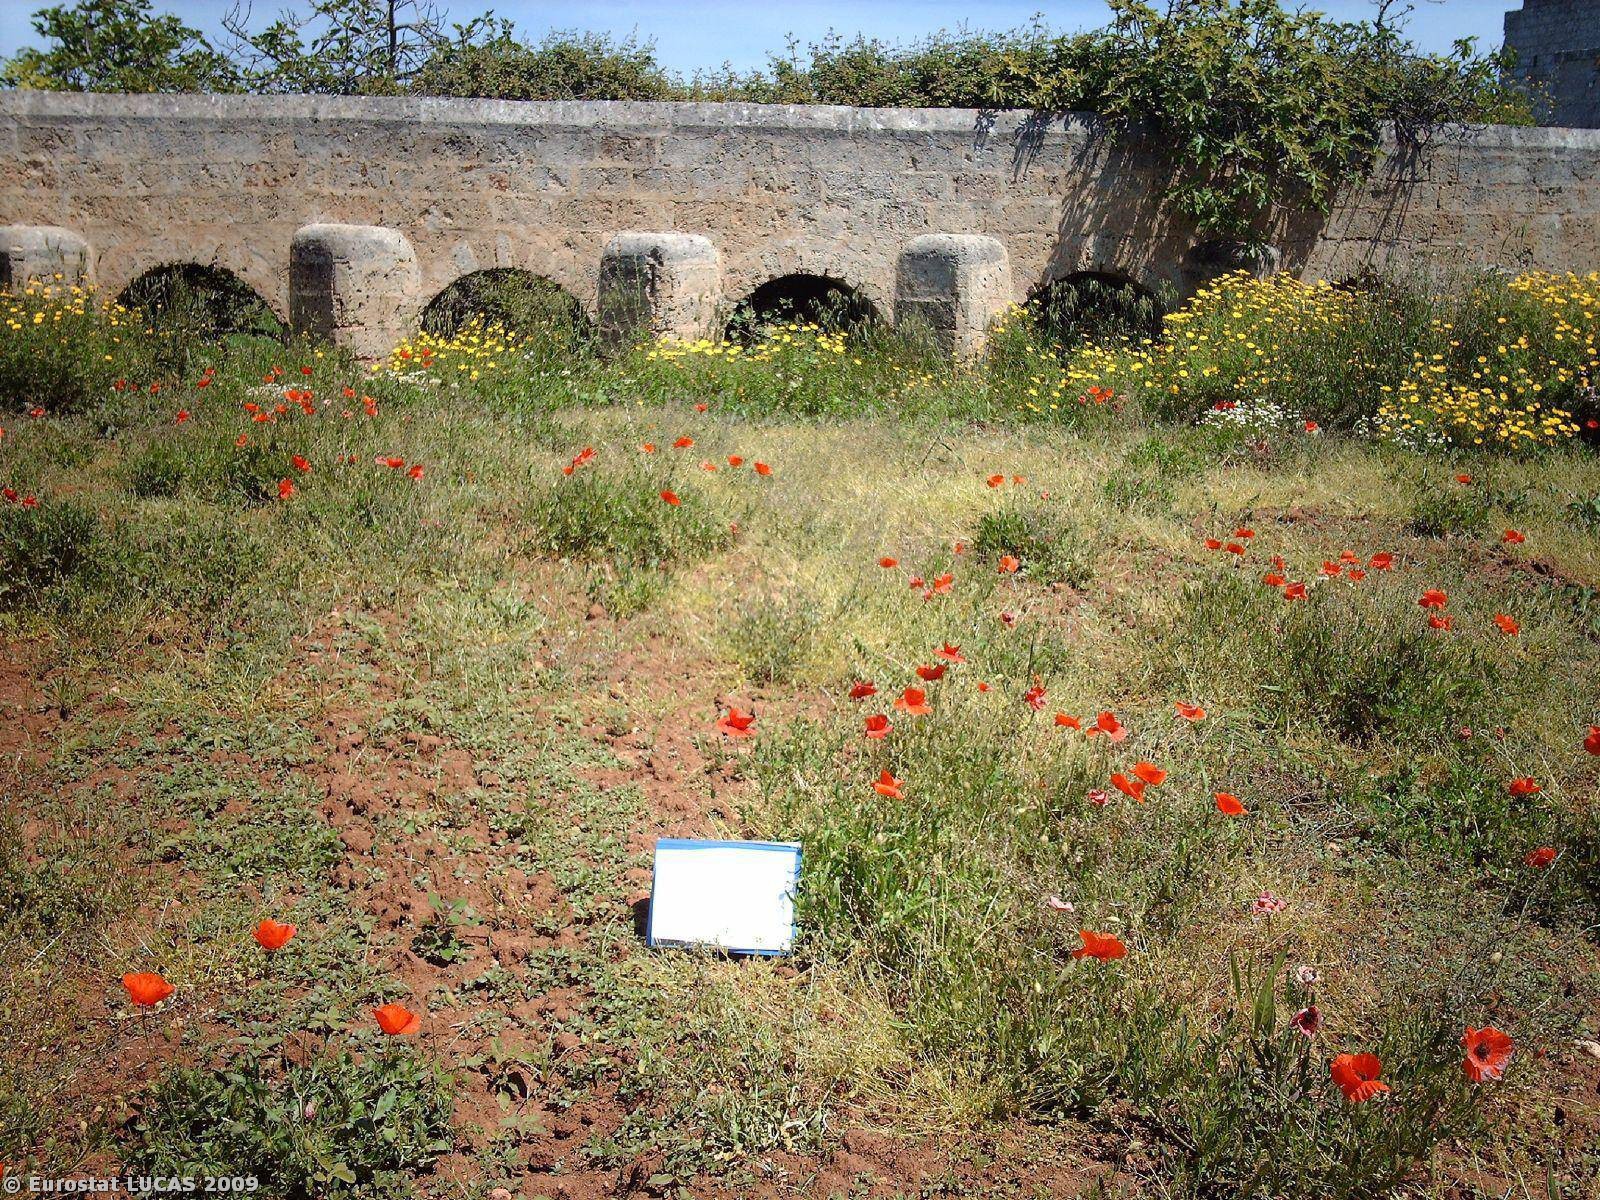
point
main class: Grassland
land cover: Spontaneously vegetated surfaces
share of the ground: > 75 %
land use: Fallow land
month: May
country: IT
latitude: 40.7916
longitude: 17.5744
